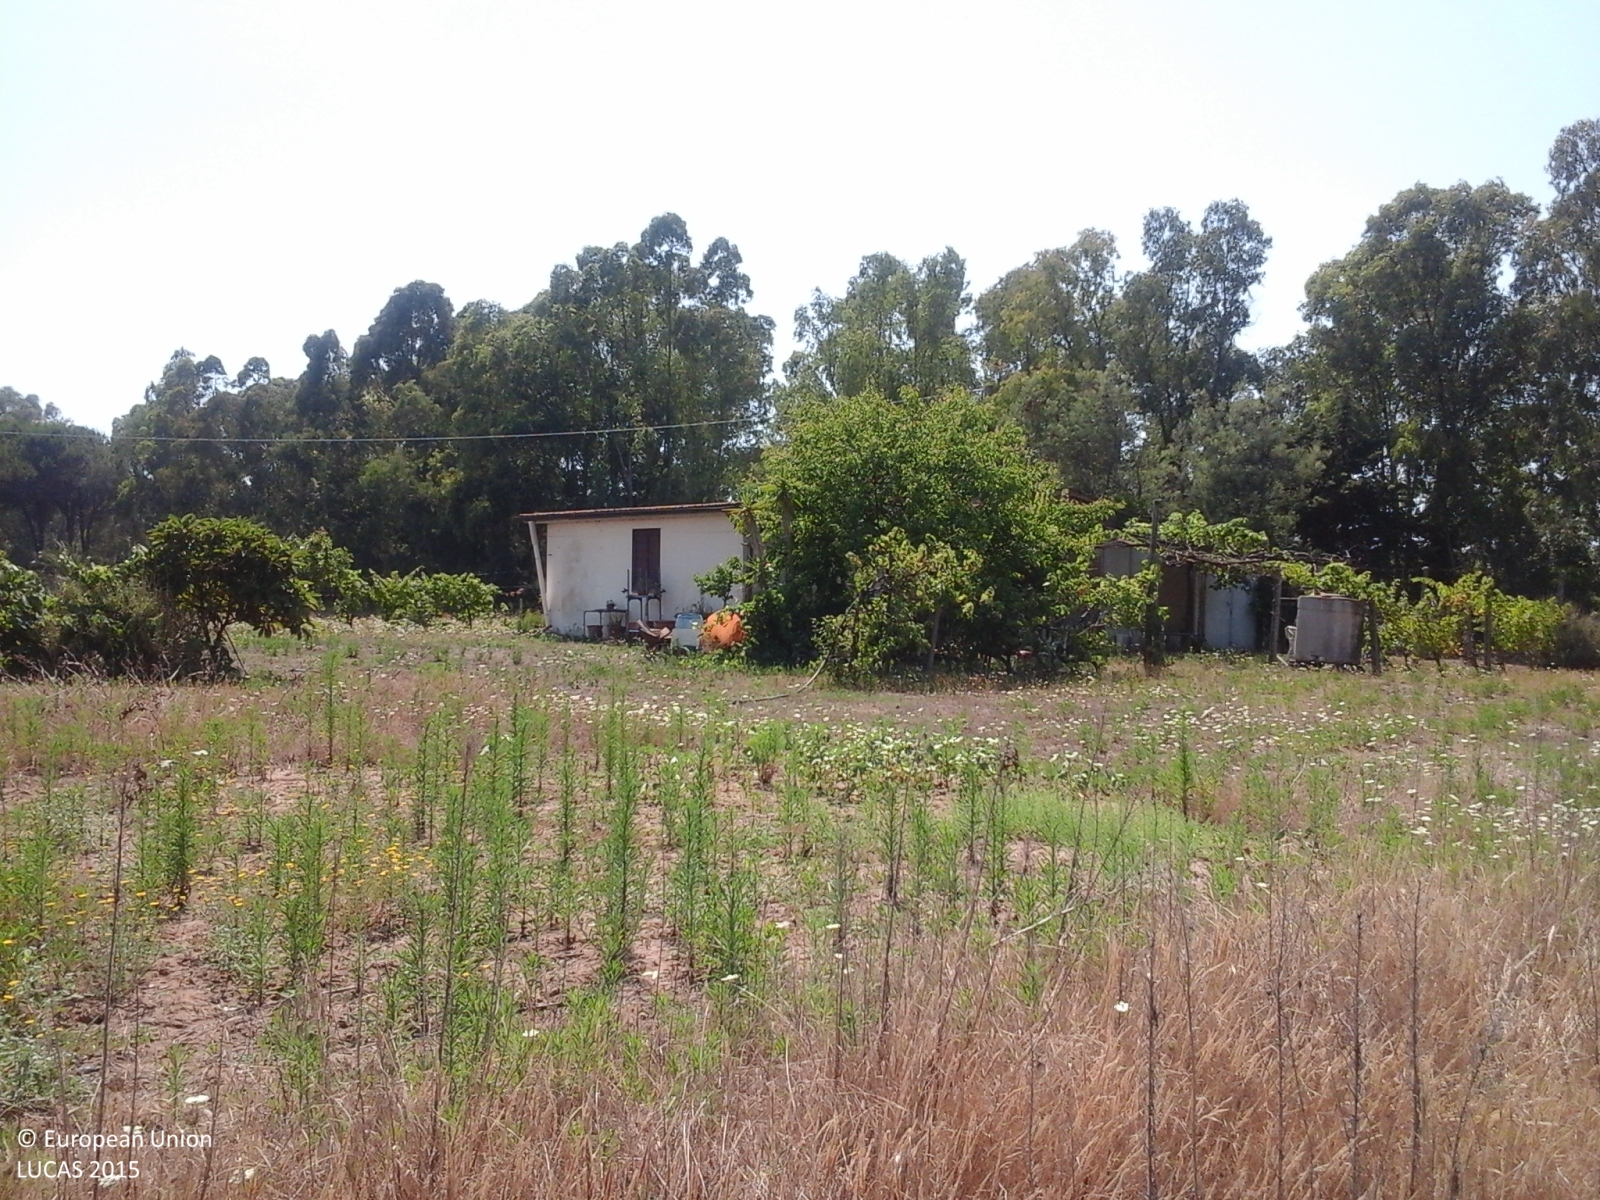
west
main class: Grassland
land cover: Spontaneously vegetated surfaces
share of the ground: > 75 %
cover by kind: herbaceous plants 100 %
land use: Agriculture (excluding fallow land and kitchen gardens)
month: June
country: IT
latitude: 42.7398
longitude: 10.9618
